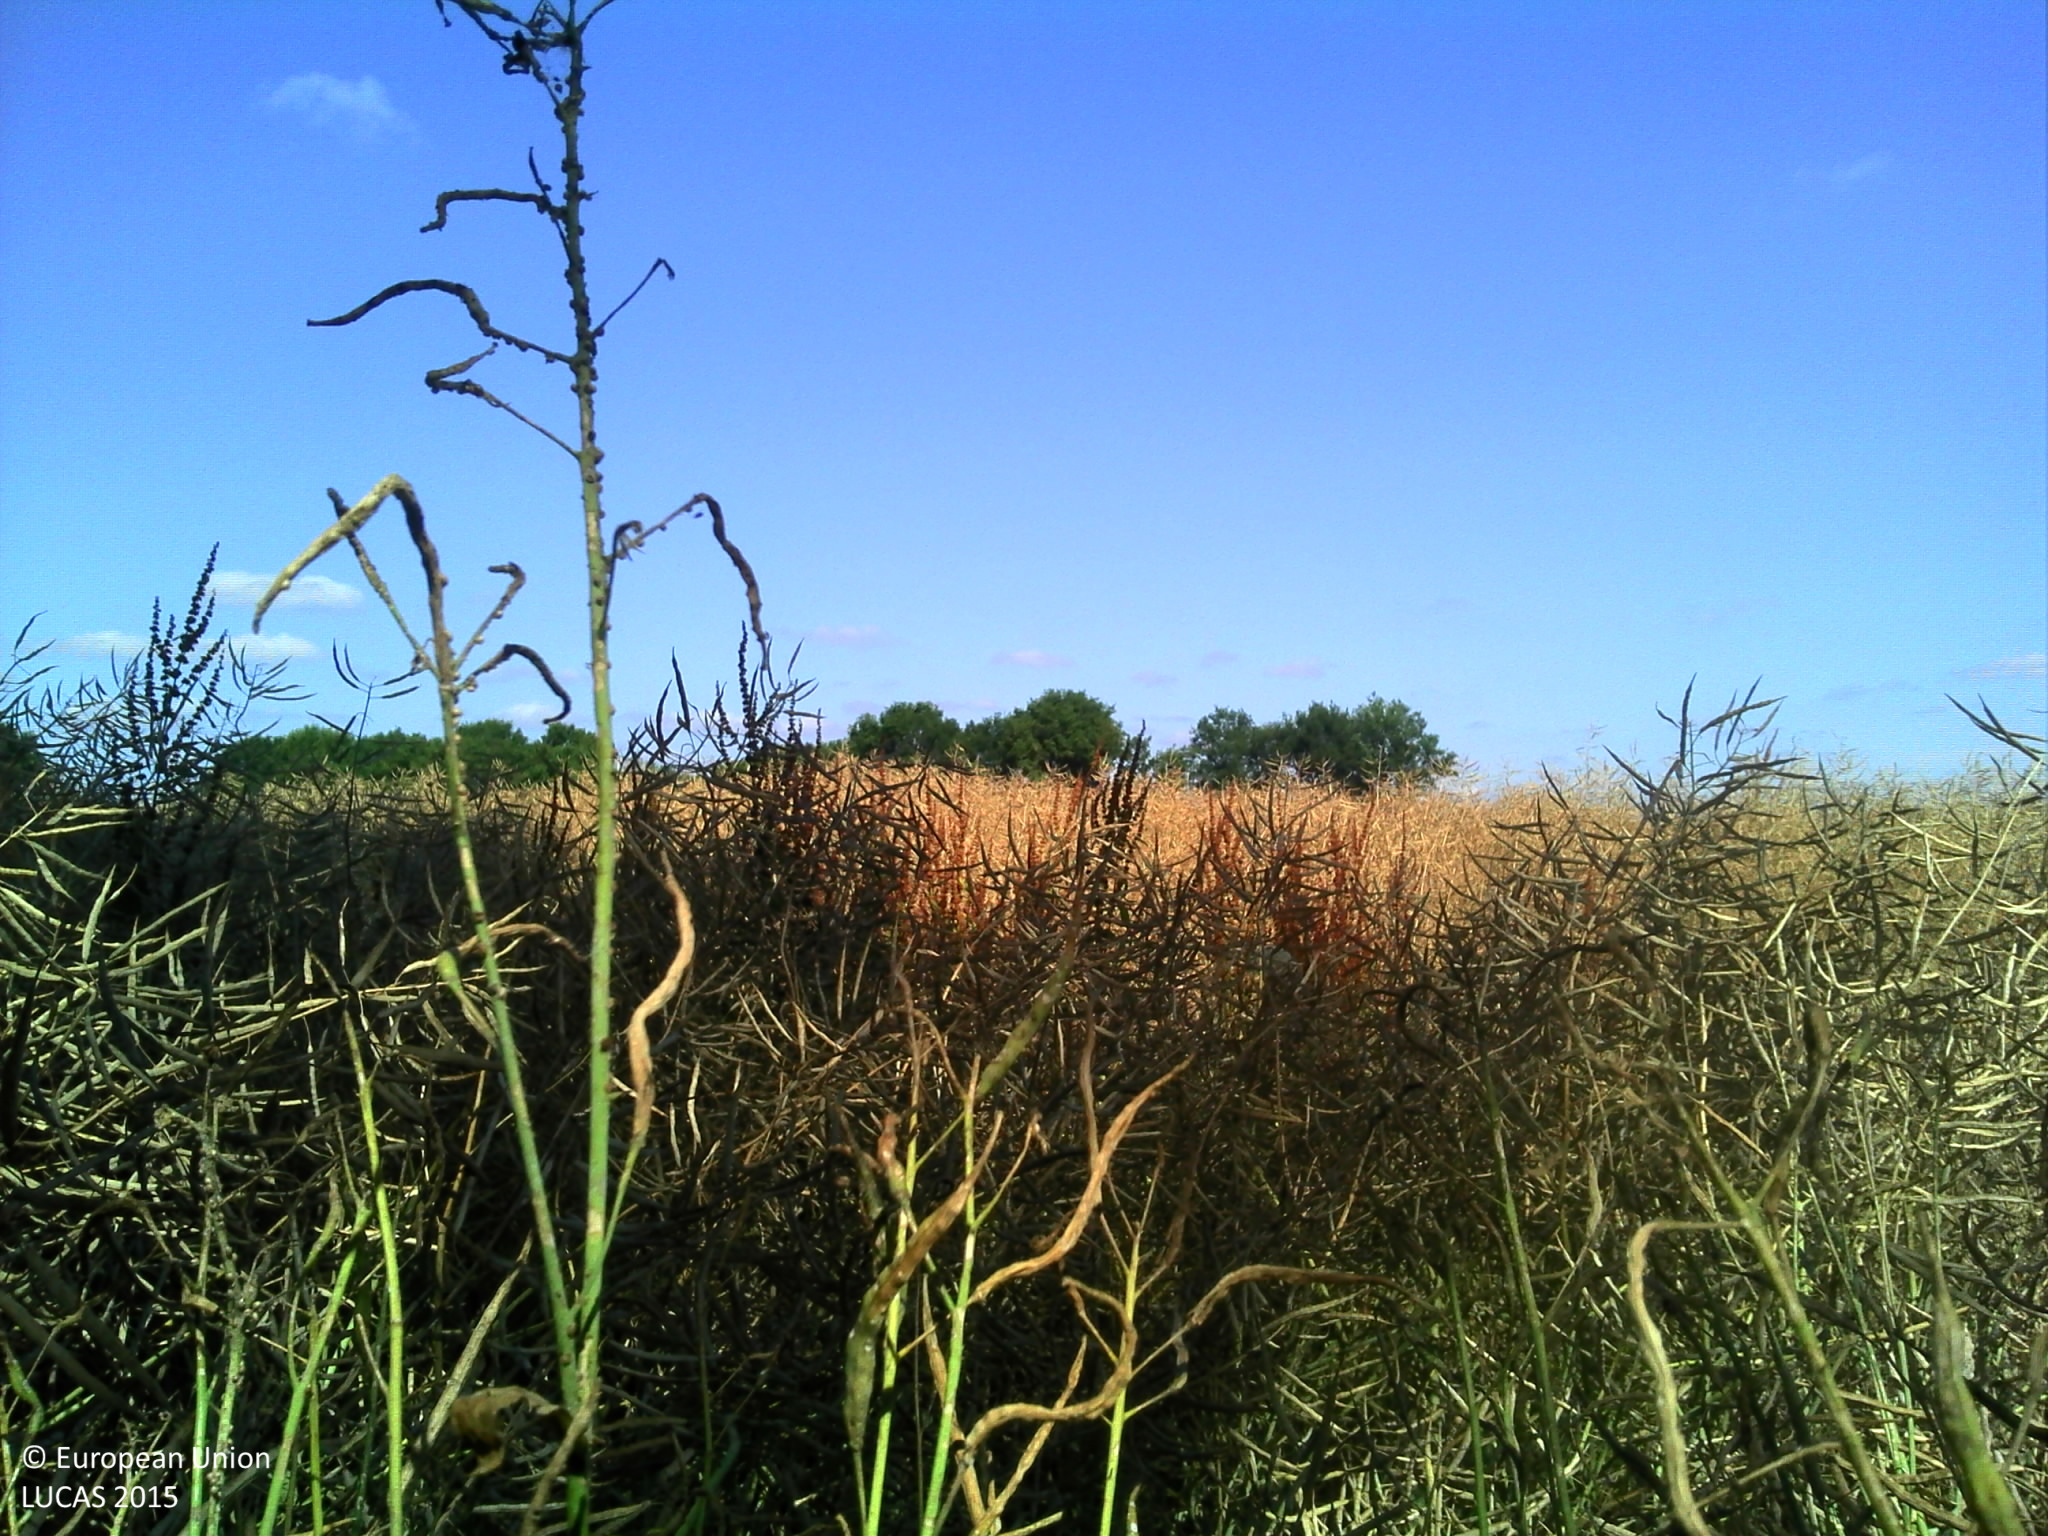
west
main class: Cropland
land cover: Rape and turnip rape
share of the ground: > 75 %
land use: Agriculture (excluding fallow land and kitchen gardens)
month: July
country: FR
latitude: 47.9294
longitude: 0.5953
